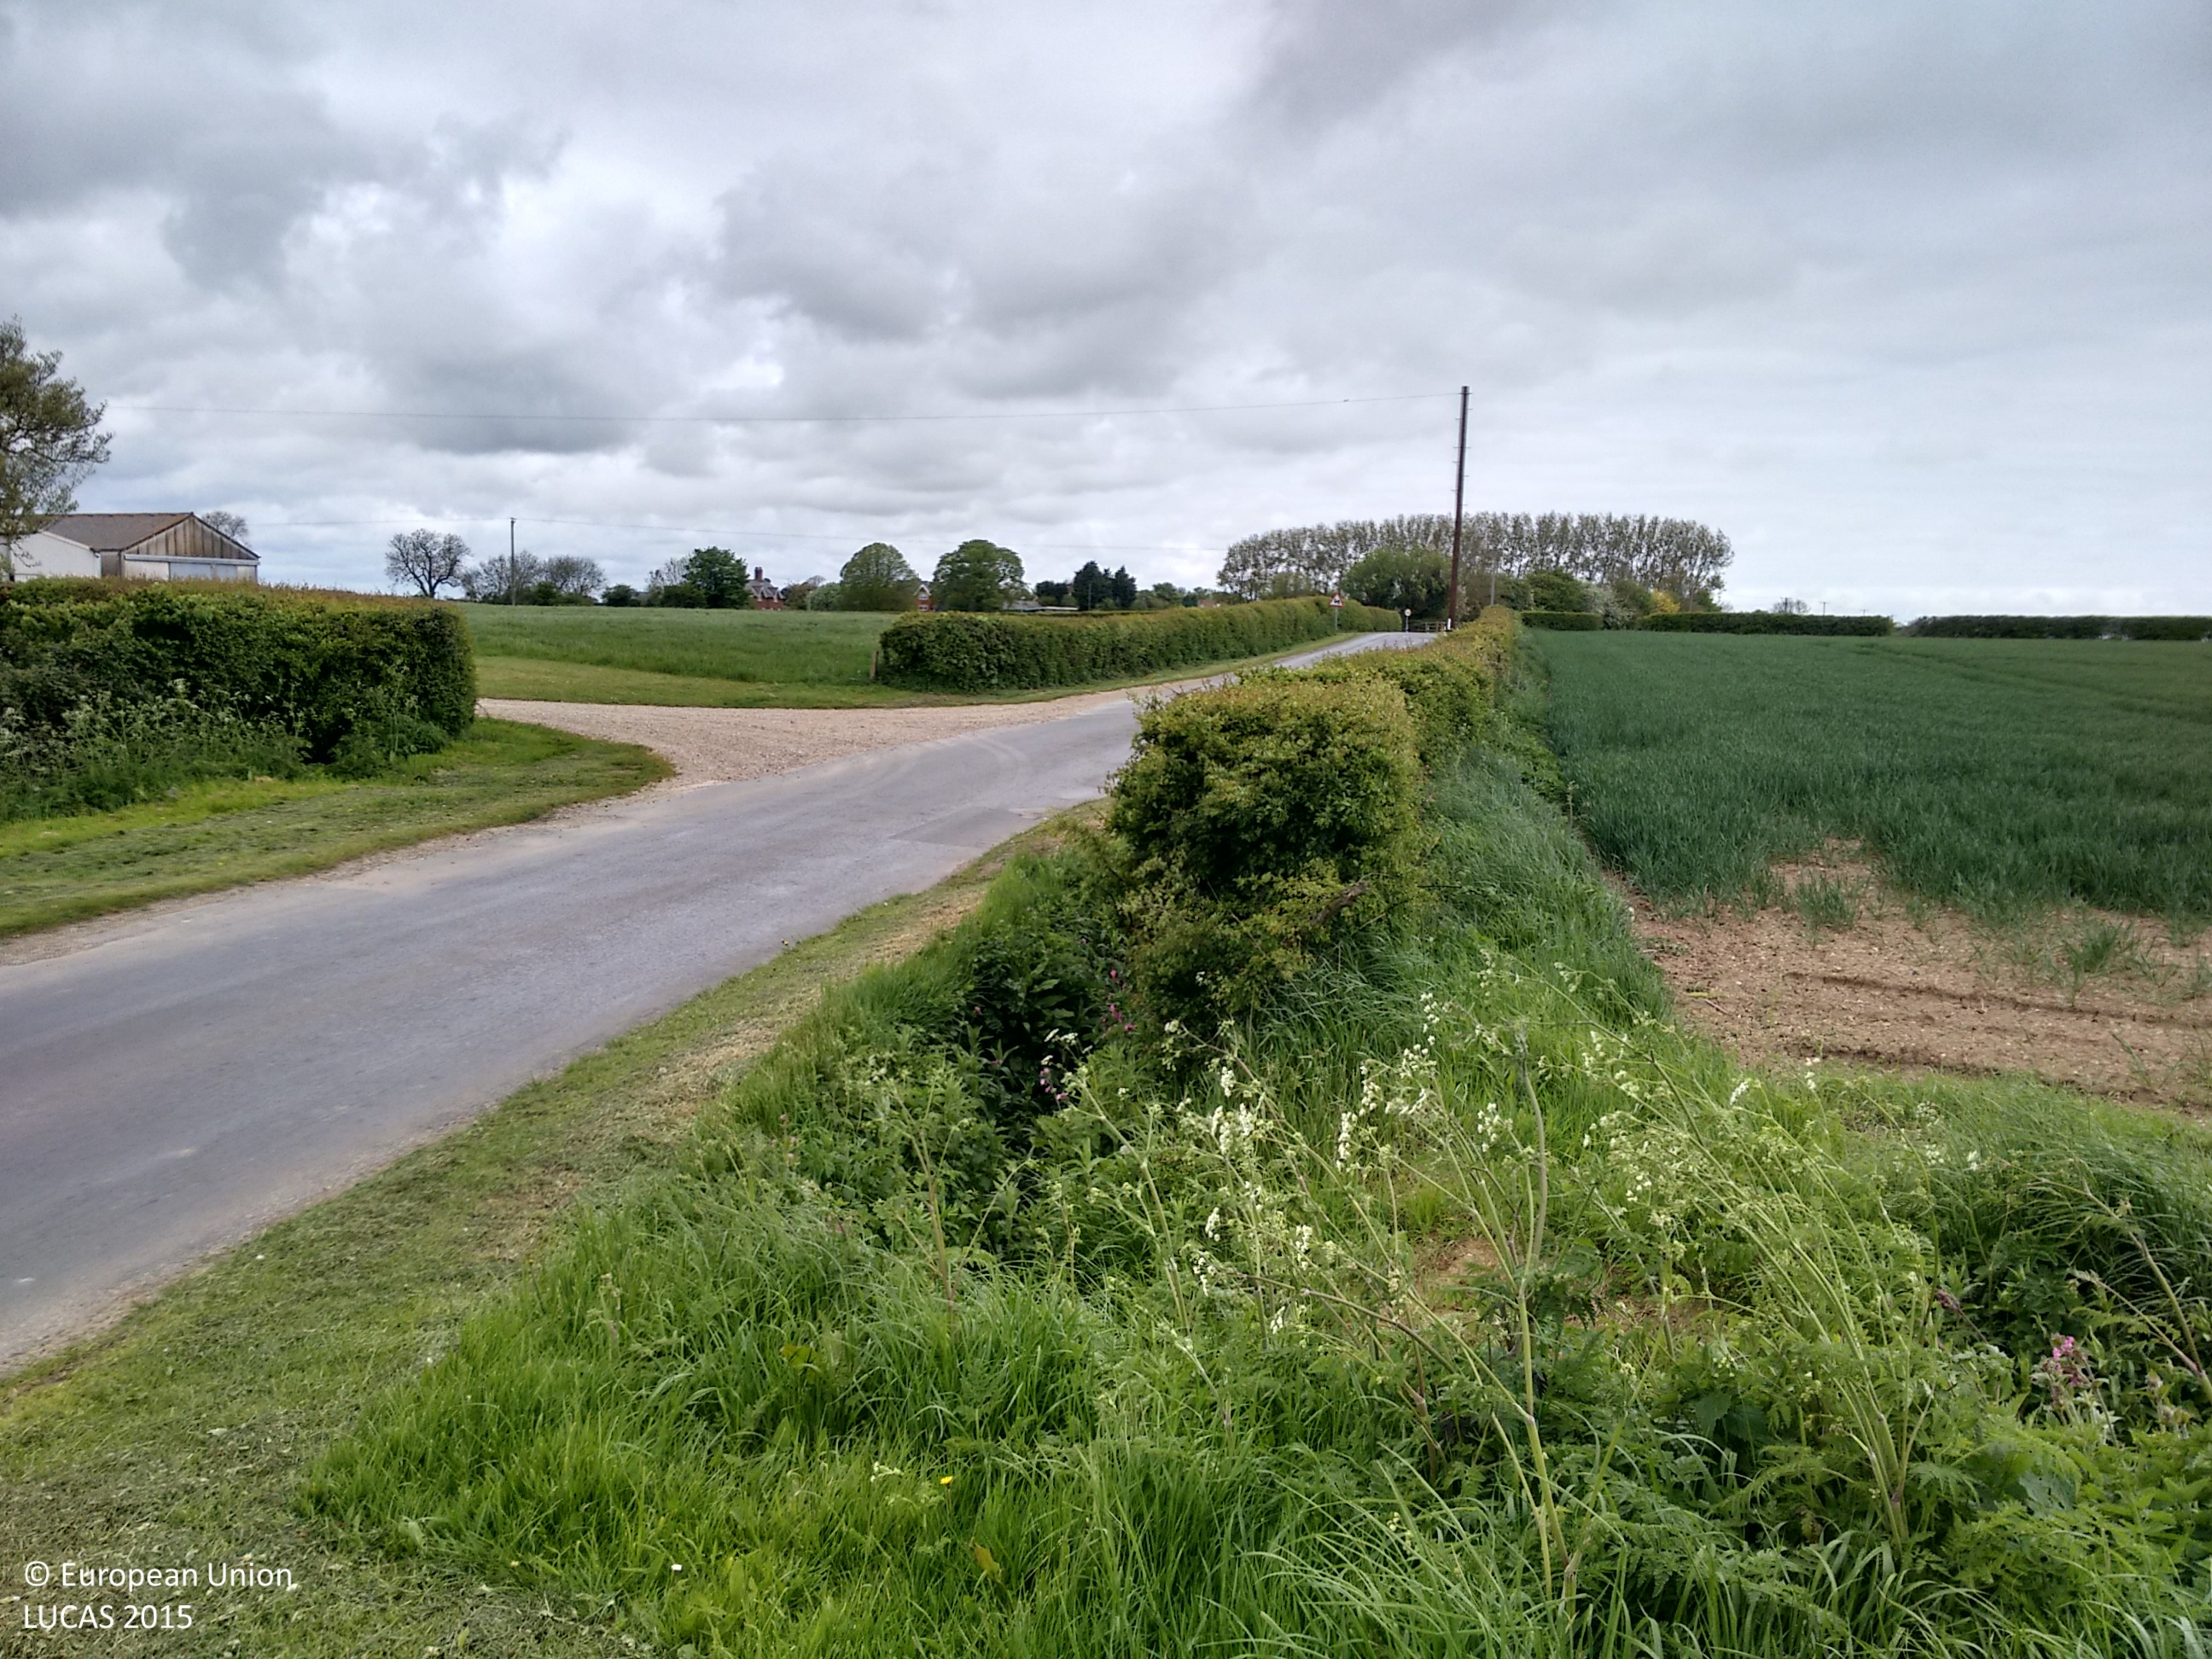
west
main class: Cropland
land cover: Common wheat
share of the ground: > 75 %
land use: Agriculture (excluding fallow land and kitchen gardens)
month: May
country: GB
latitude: 53.7919
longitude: -0.1274
